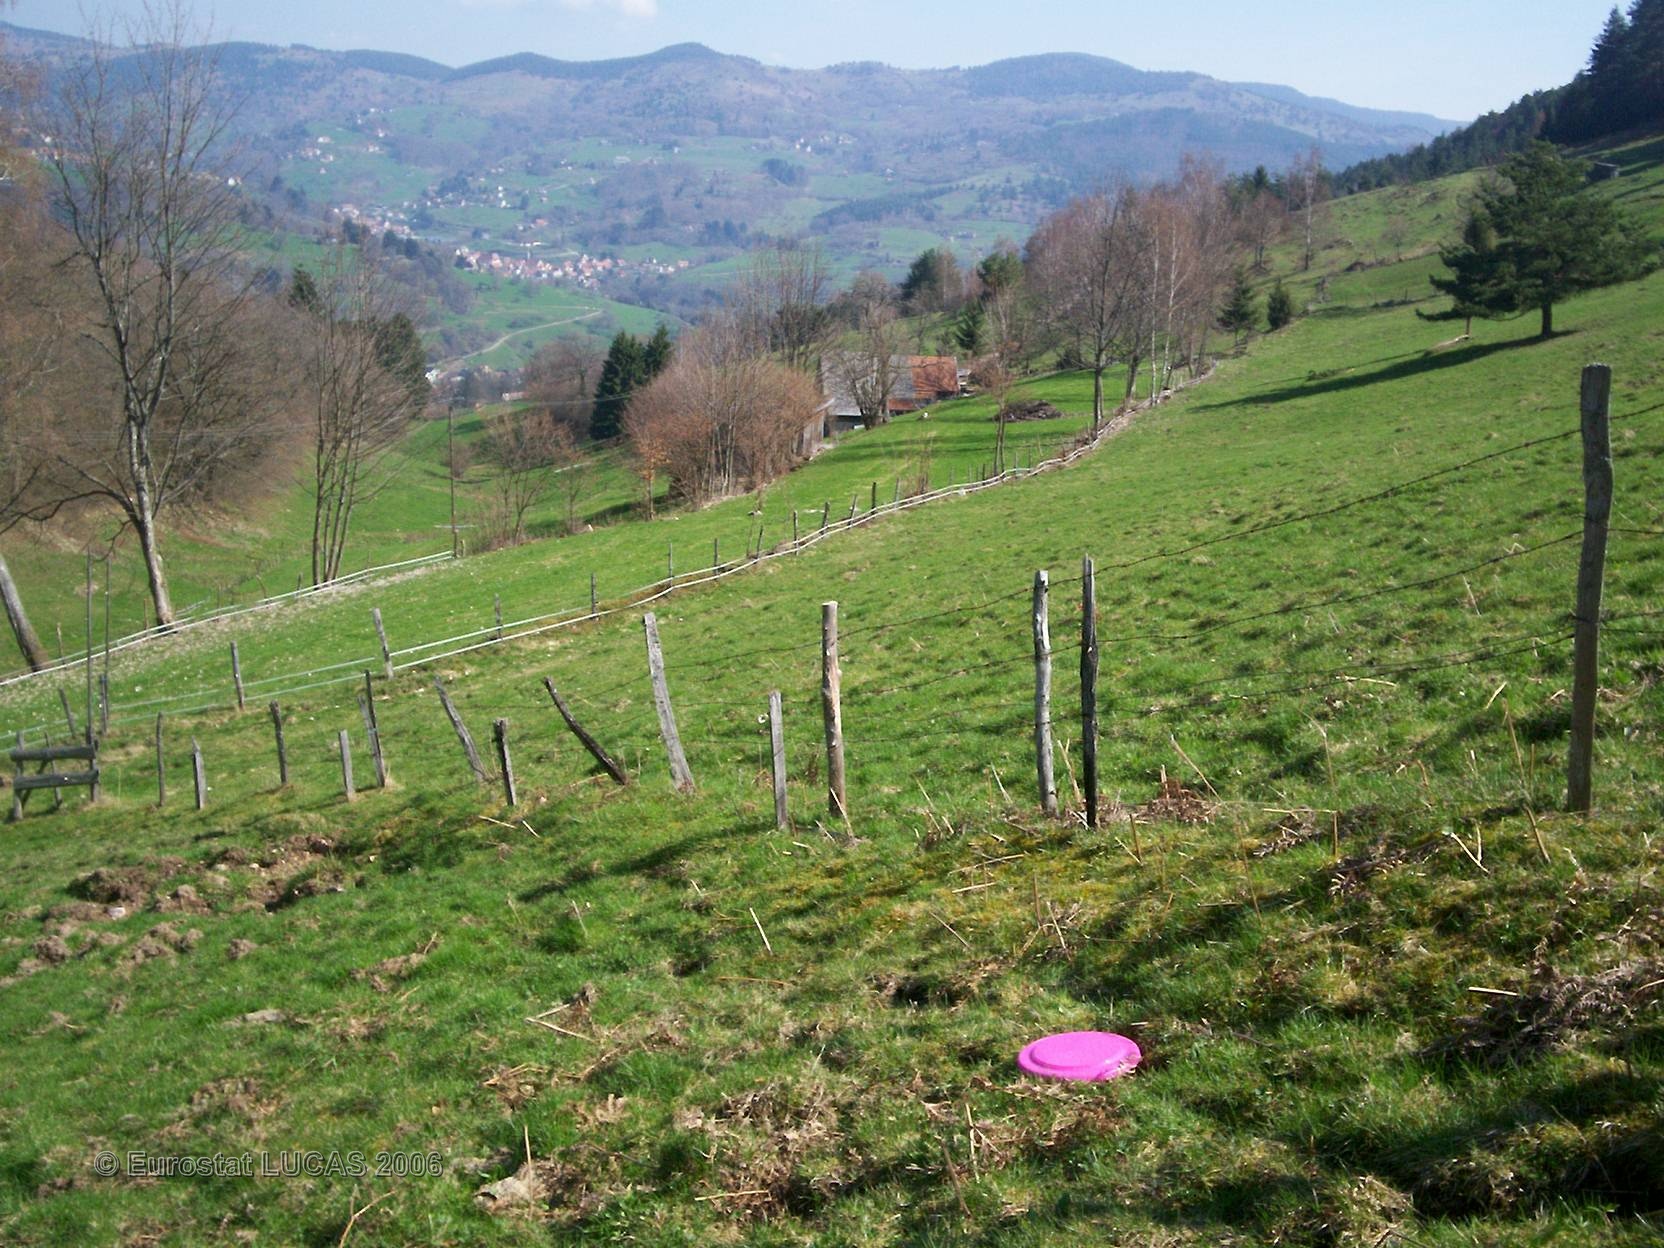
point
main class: Grassland
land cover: Grassland without tree/shrub cover
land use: Agriculture (excluding fallow land and kitchen gardens)
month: April
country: FR
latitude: 48.0411
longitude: 7.0905
